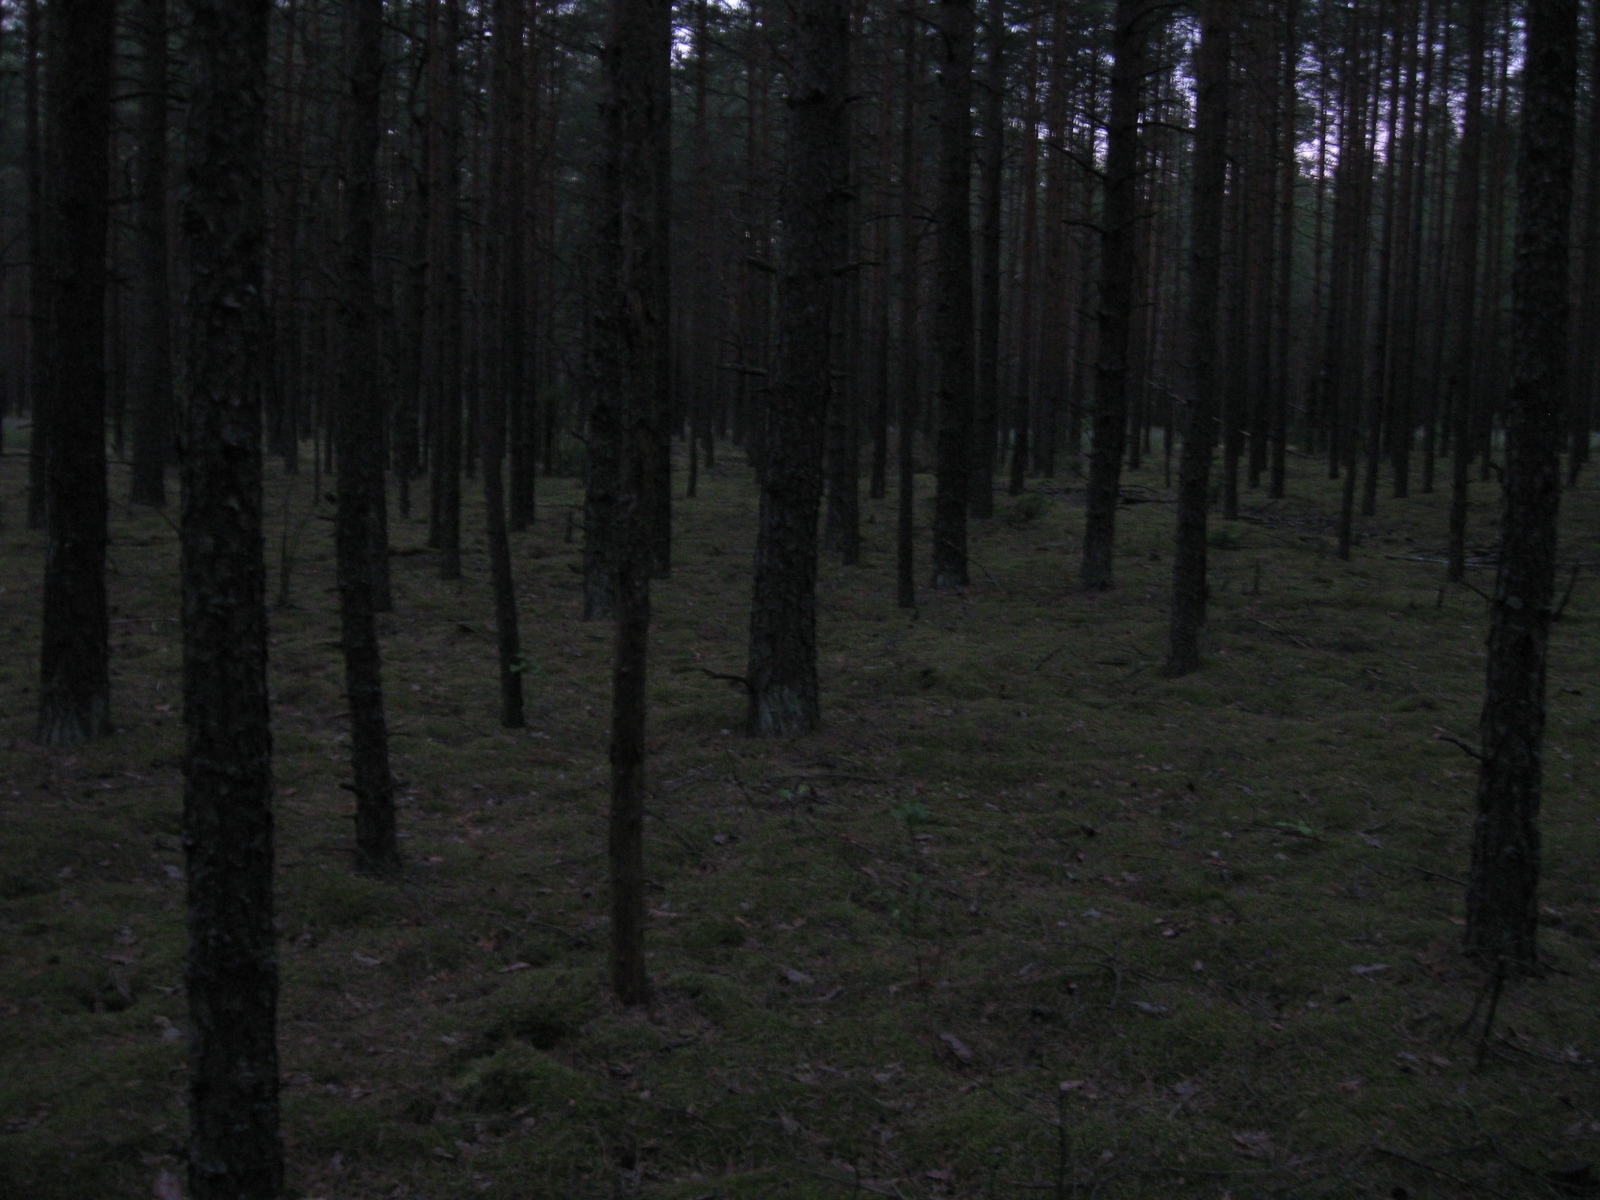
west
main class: Woodland
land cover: Pine dominated coniferous woodland
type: hemiboreal forest and nemoral coniferous forest and mixed broadleaved-coniferous forest
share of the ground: > 75 %
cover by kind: coniferous forest trees 90 %, lichens and mosses 10 %
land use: Forestry
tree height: > 5 m
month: June
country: LT
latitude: 54.1283
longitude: 24.2220
